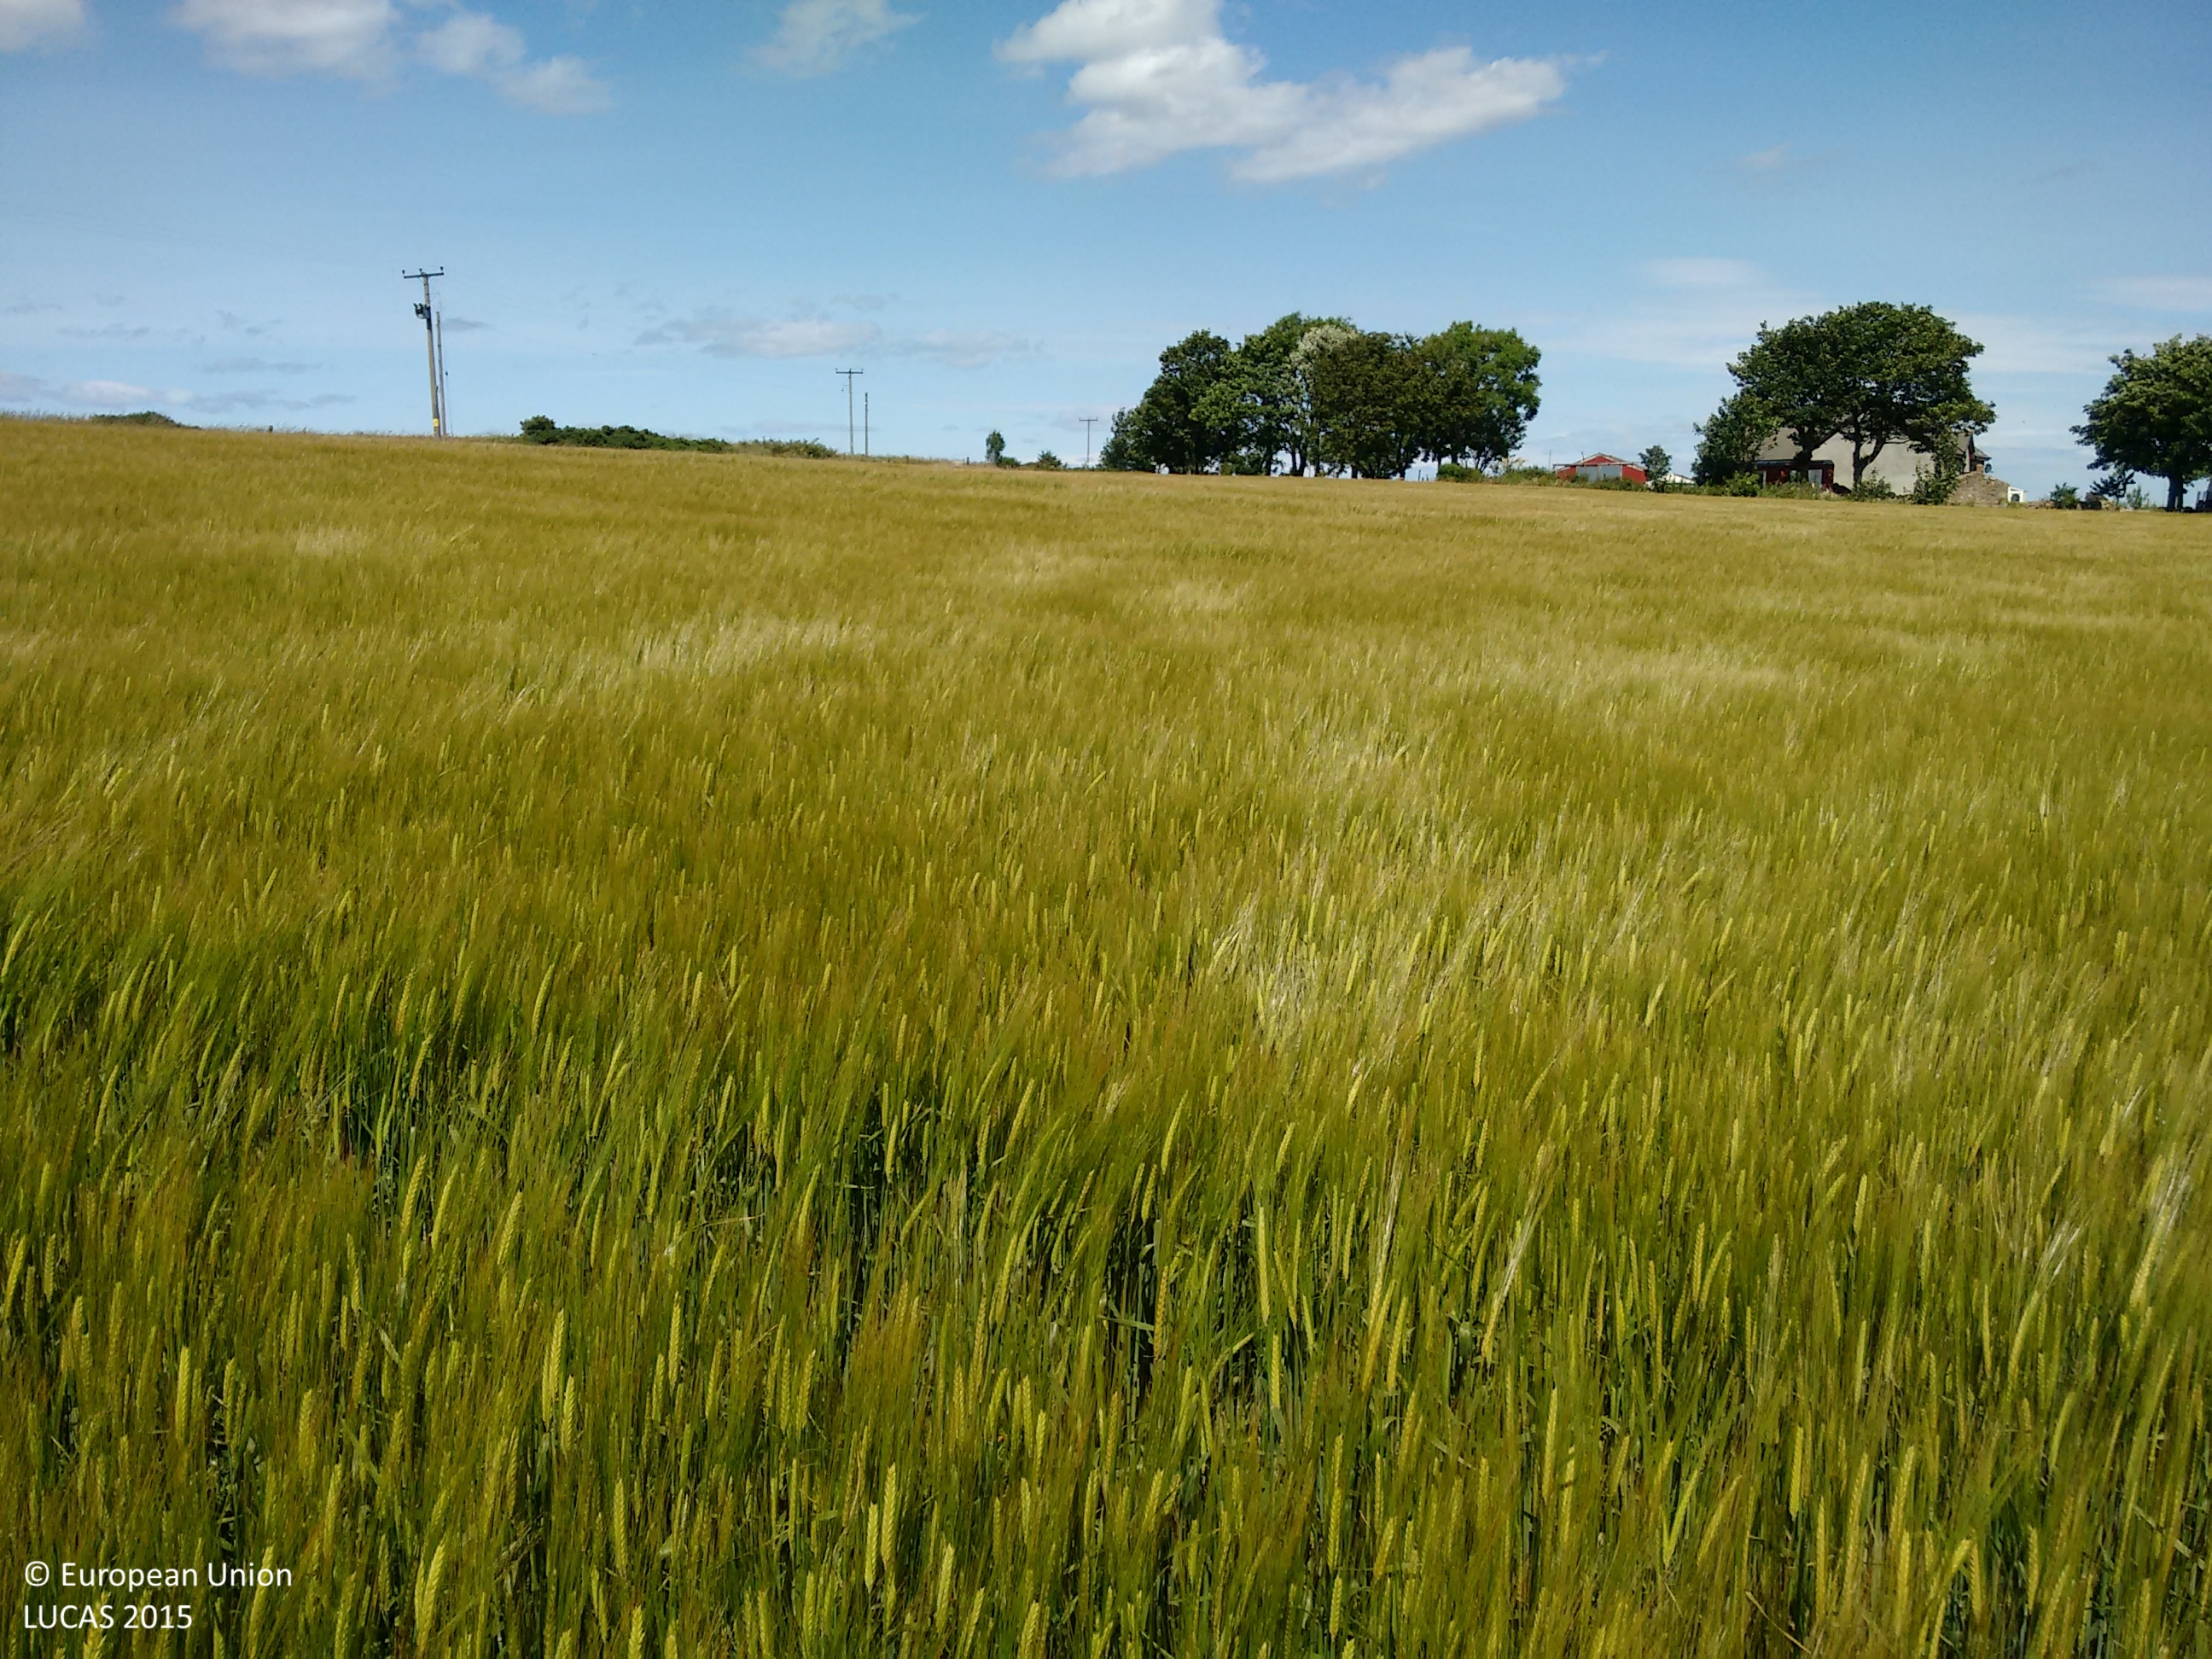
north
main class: Cropland
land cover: Barley
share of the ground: > 75 %
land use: Agriculture (excluding fallow land and kitchen gardens)
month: July
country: GB
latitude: 57.6320
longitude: -2.1213
